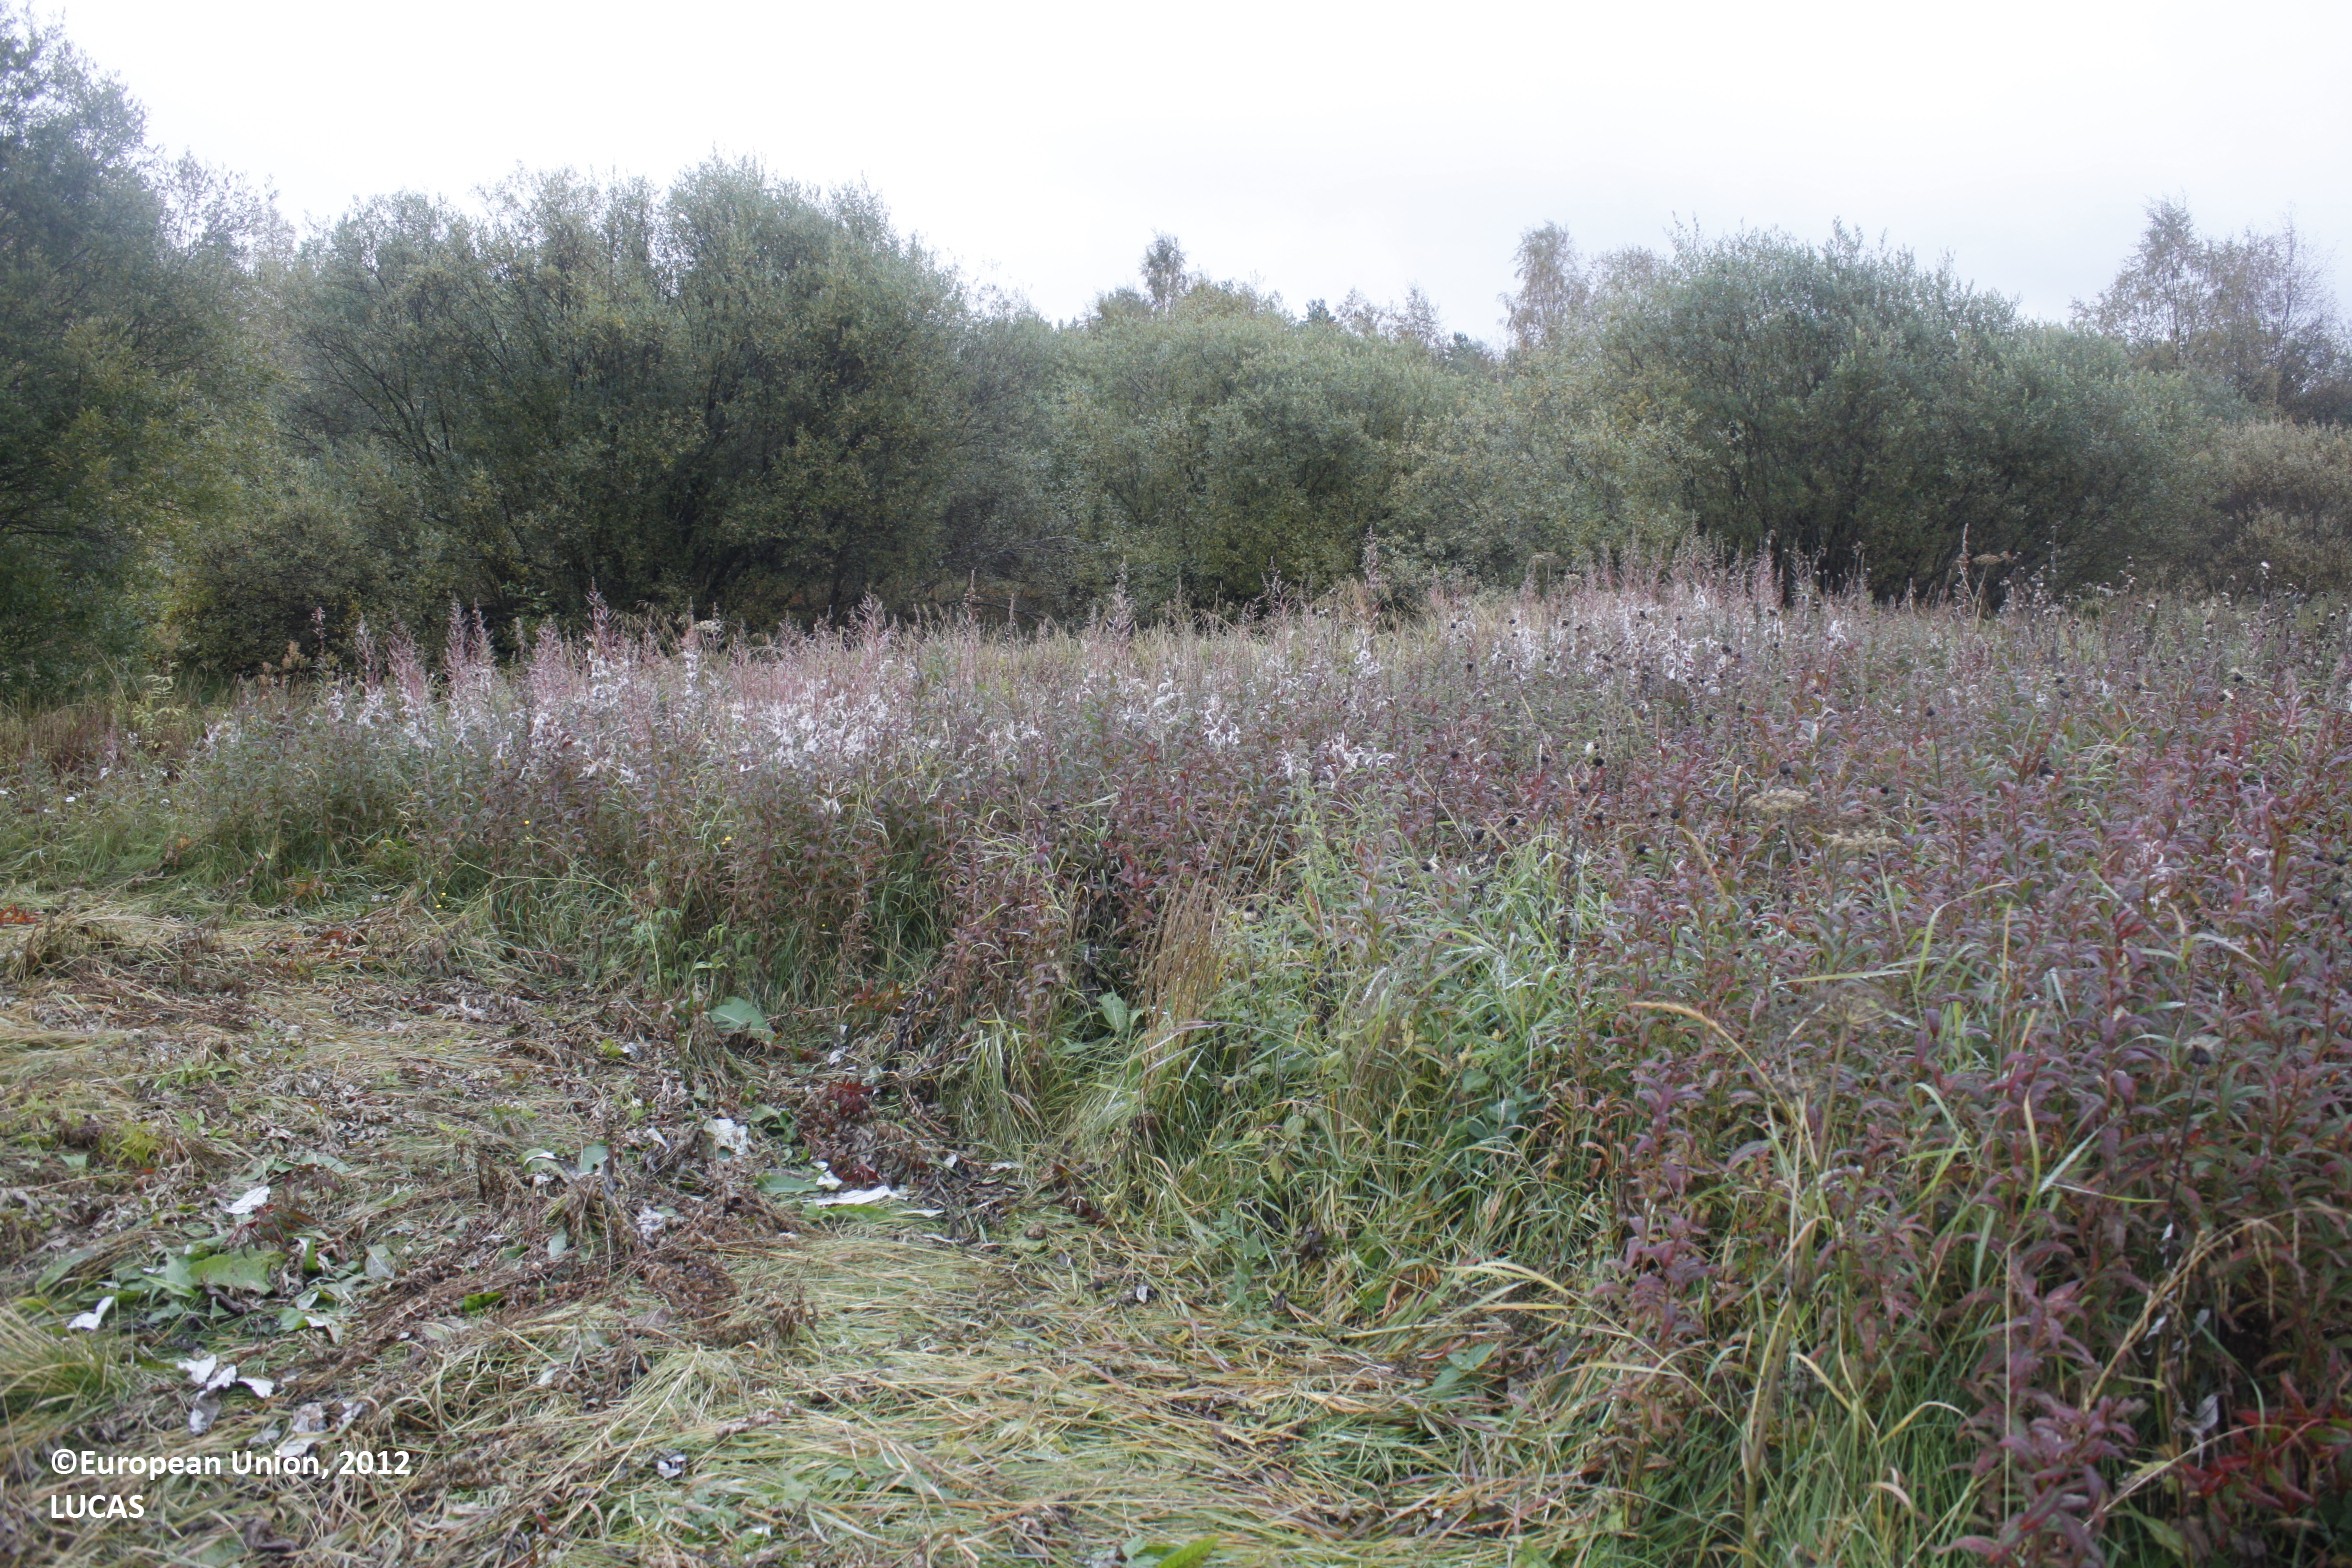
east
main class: Grassland
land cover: Spontaneously vegetated surfaces
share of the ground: > 75 %
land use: Fallow land
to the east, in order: Spontaneously vegetated surfaces; Inland running water; Broadleaved woodland
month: September
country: FI
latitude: 65.2096
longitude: 26.7189
